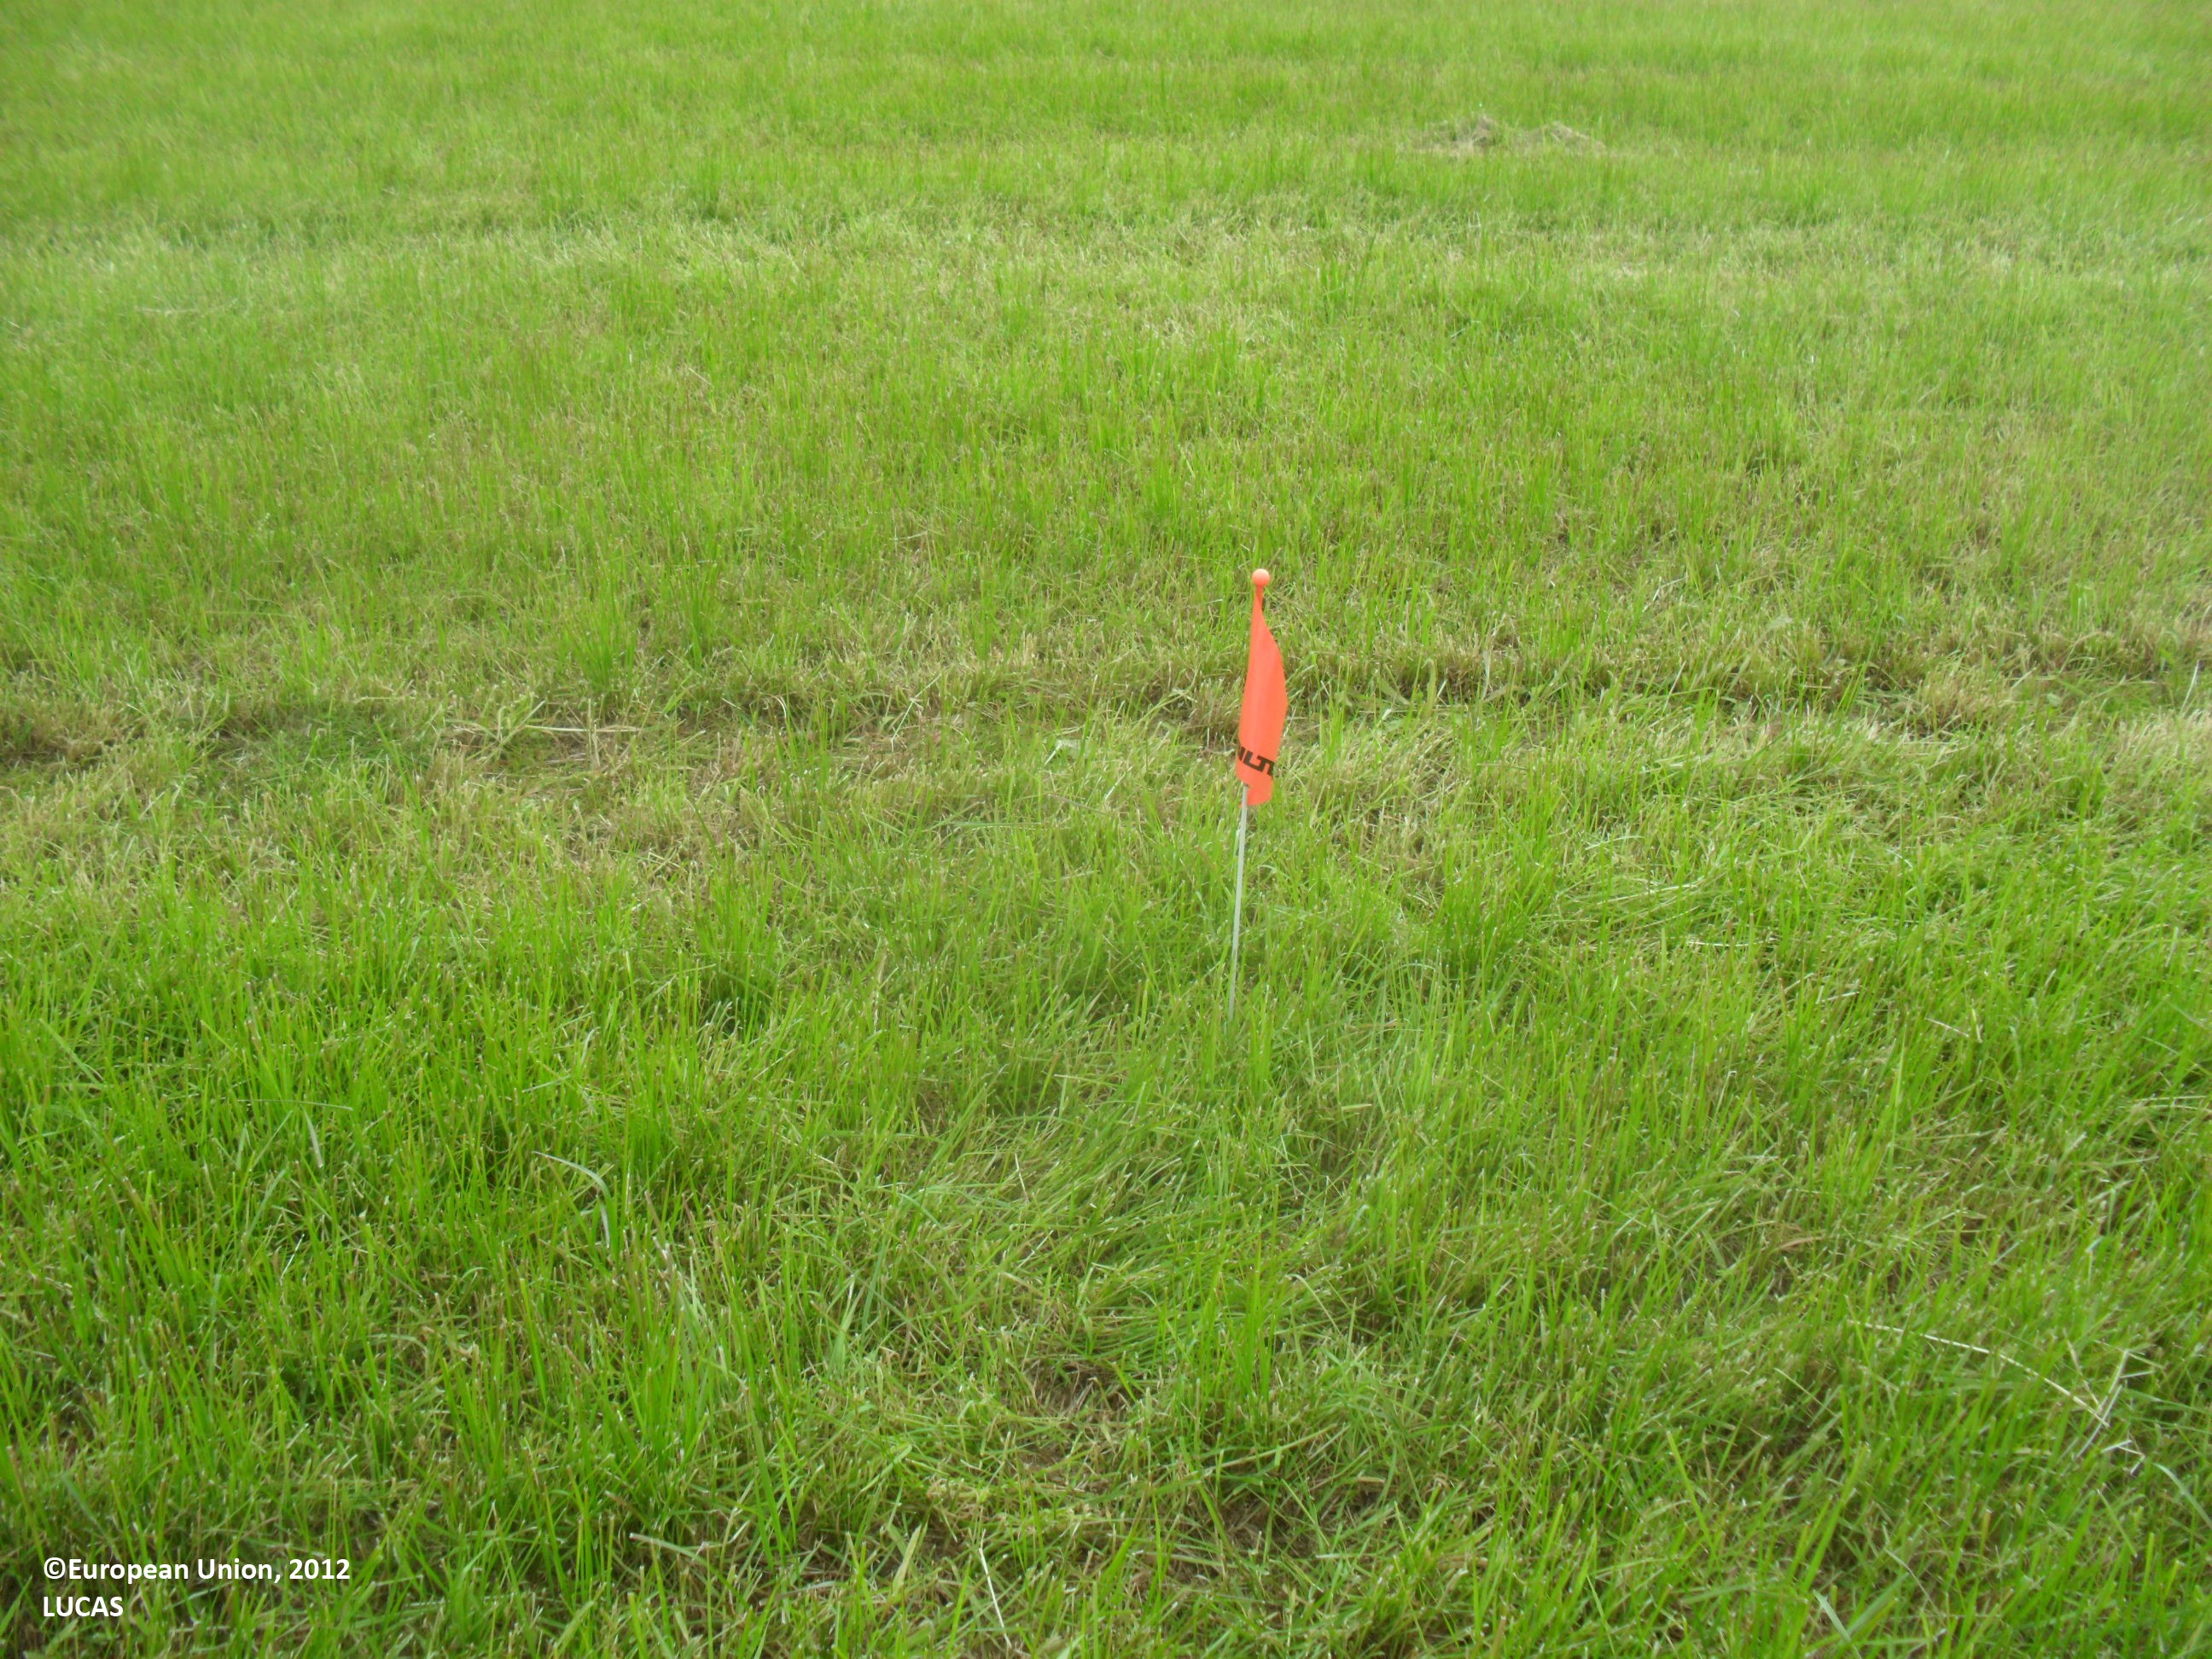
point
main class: Cropland
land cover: Temporary grasslands
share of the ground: > 75 %
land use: Agriculture (excluding fallow land and kitchen gardens)
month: June
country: FI
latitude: 63.3290
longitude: 23.4213
